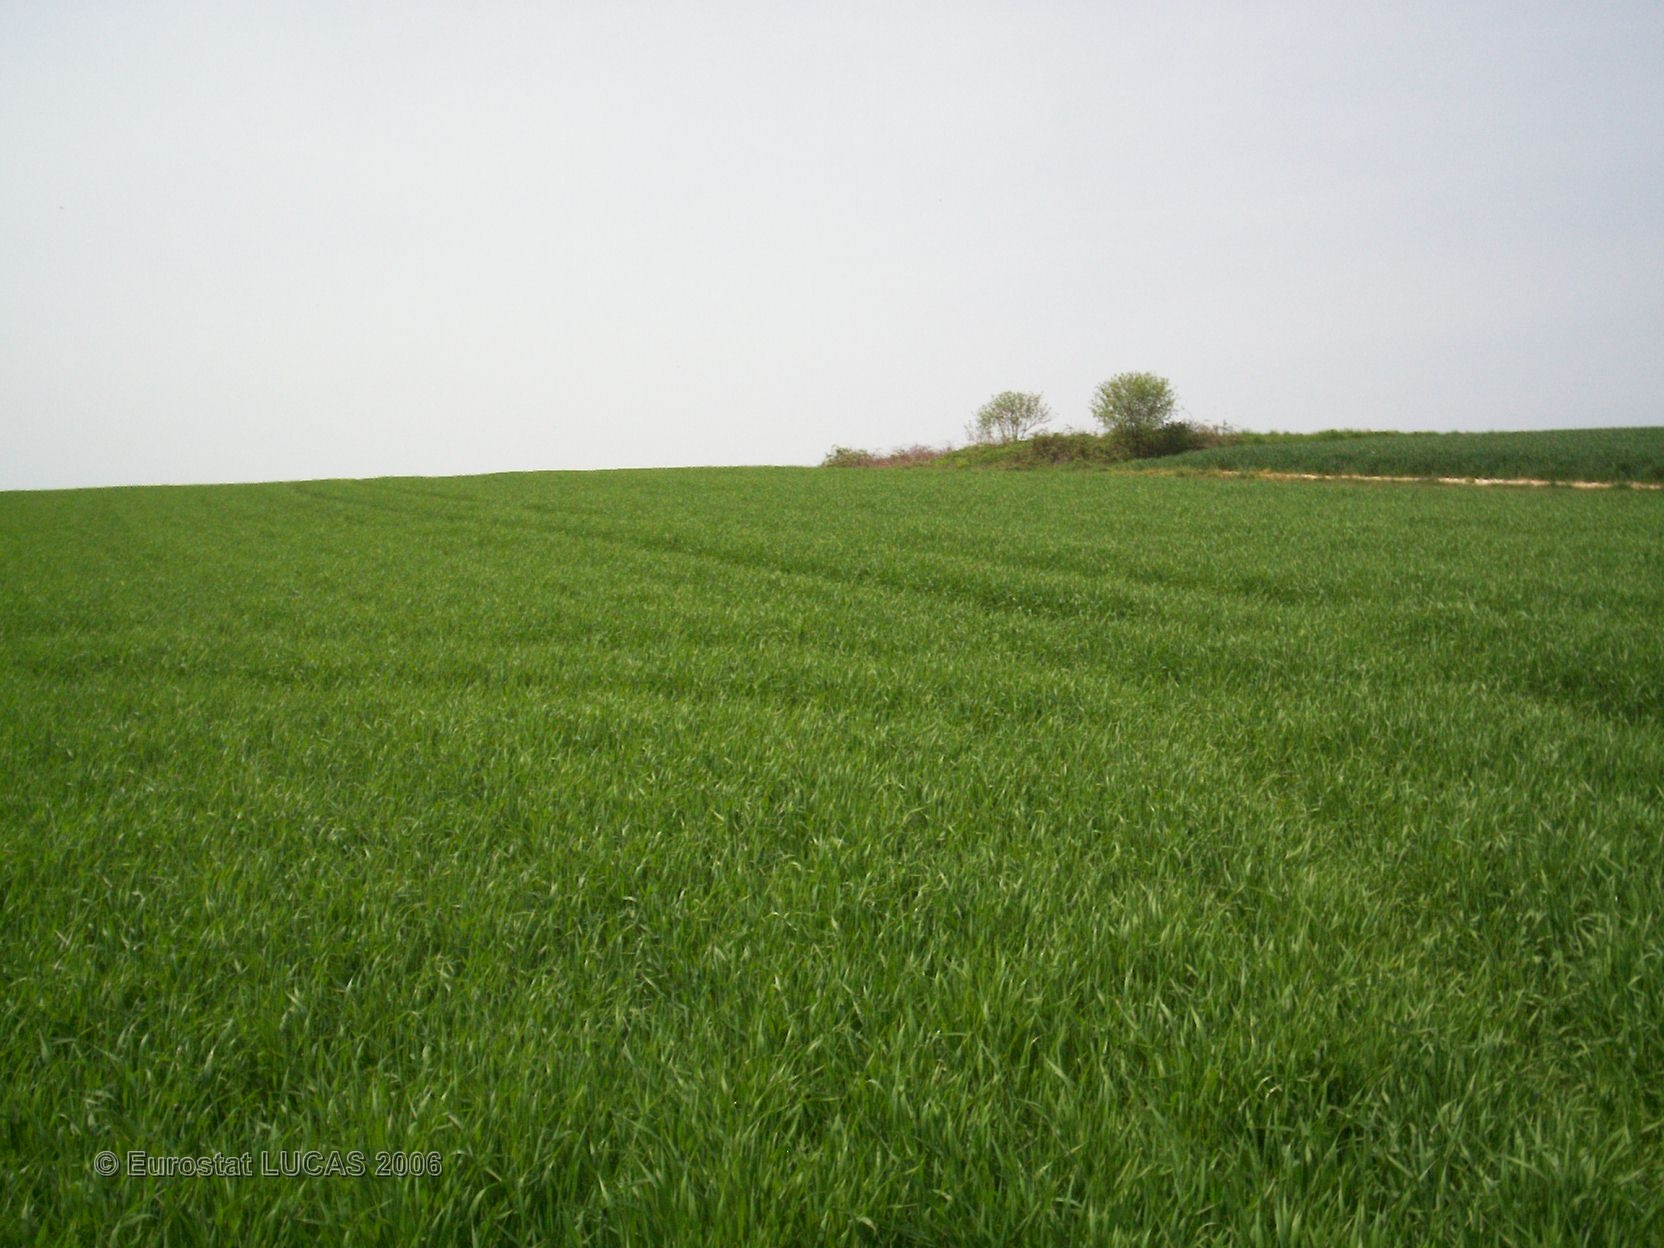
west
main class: Cropland
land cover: Barley
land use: Agriculture (excluding fallow land and kitchen gardens)
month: May
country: FR
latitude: 47.6188
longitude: 4.5305
